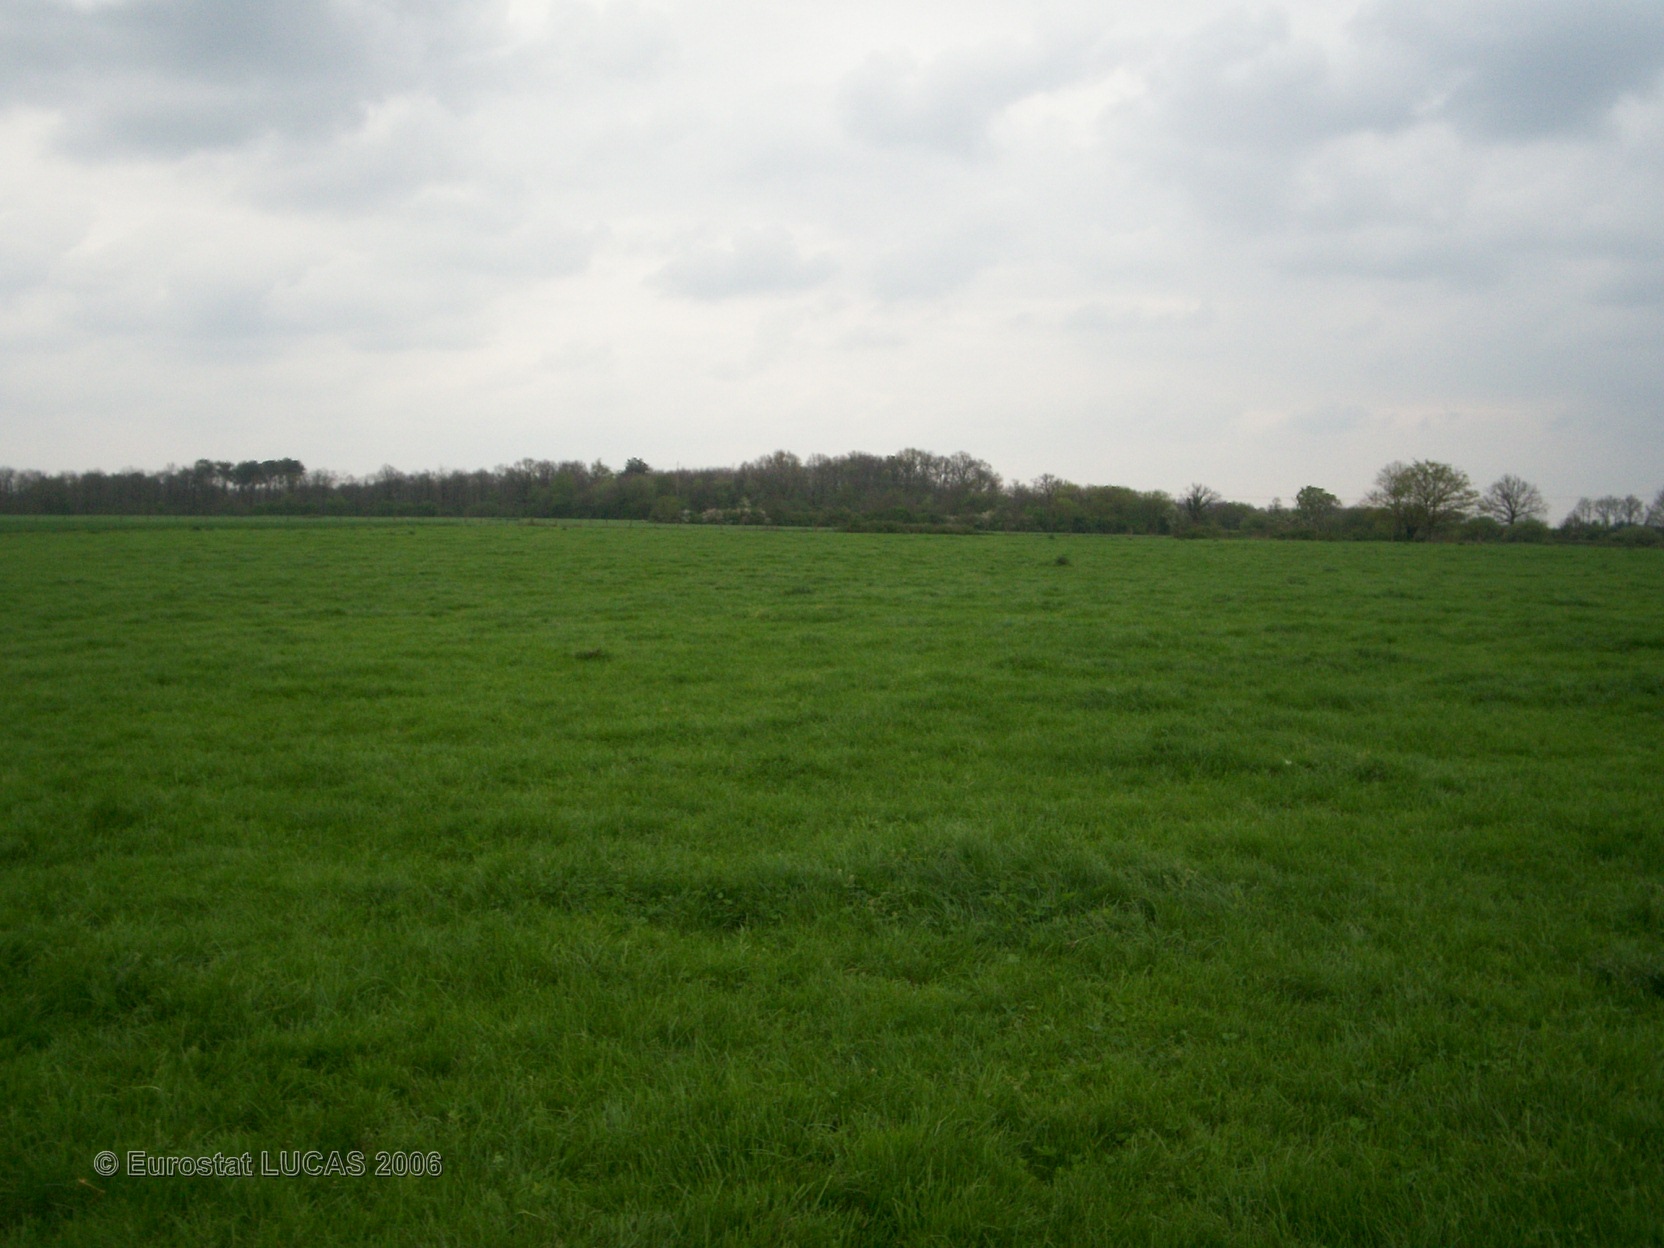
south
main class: Grassland
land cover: Grassland without tree/shrub cover
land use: Agriculture (excluding fallow land and kitchen gardens)
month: April
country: FR
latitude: 46.8382
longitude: -1.3265
